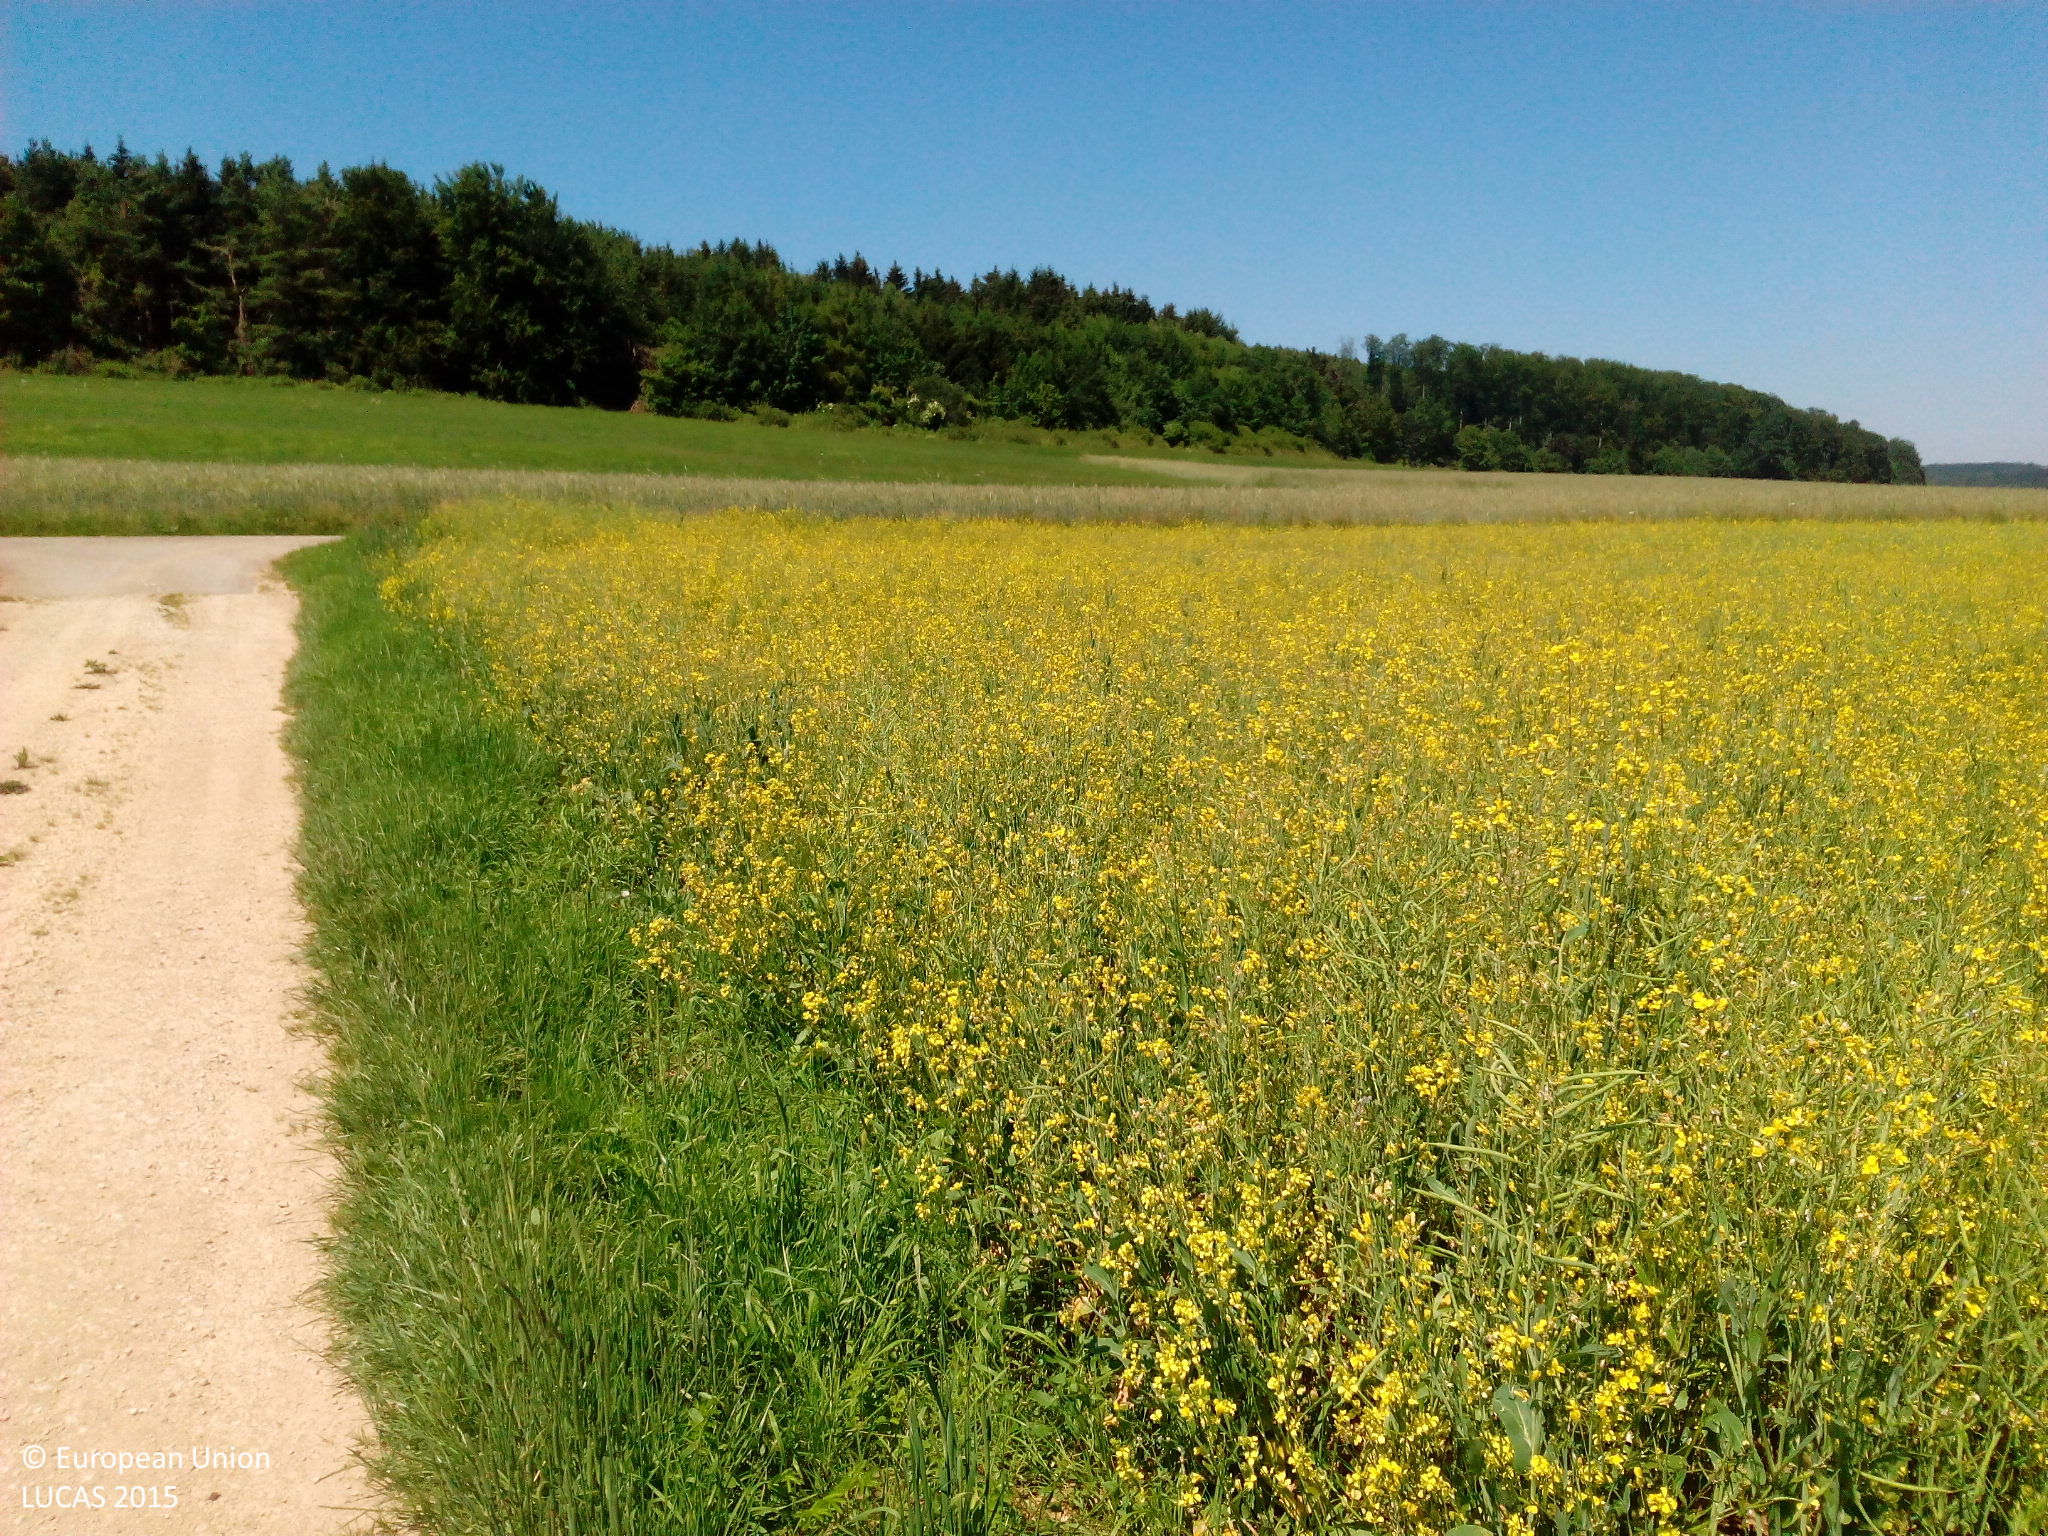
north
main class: Cropland
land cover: Rape and turnip rape
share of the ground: > 75 %
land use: Agriculture (excluding fallow land and kitchen gardens)
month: July
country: DE
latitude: 48.3120
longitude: 9.4205
